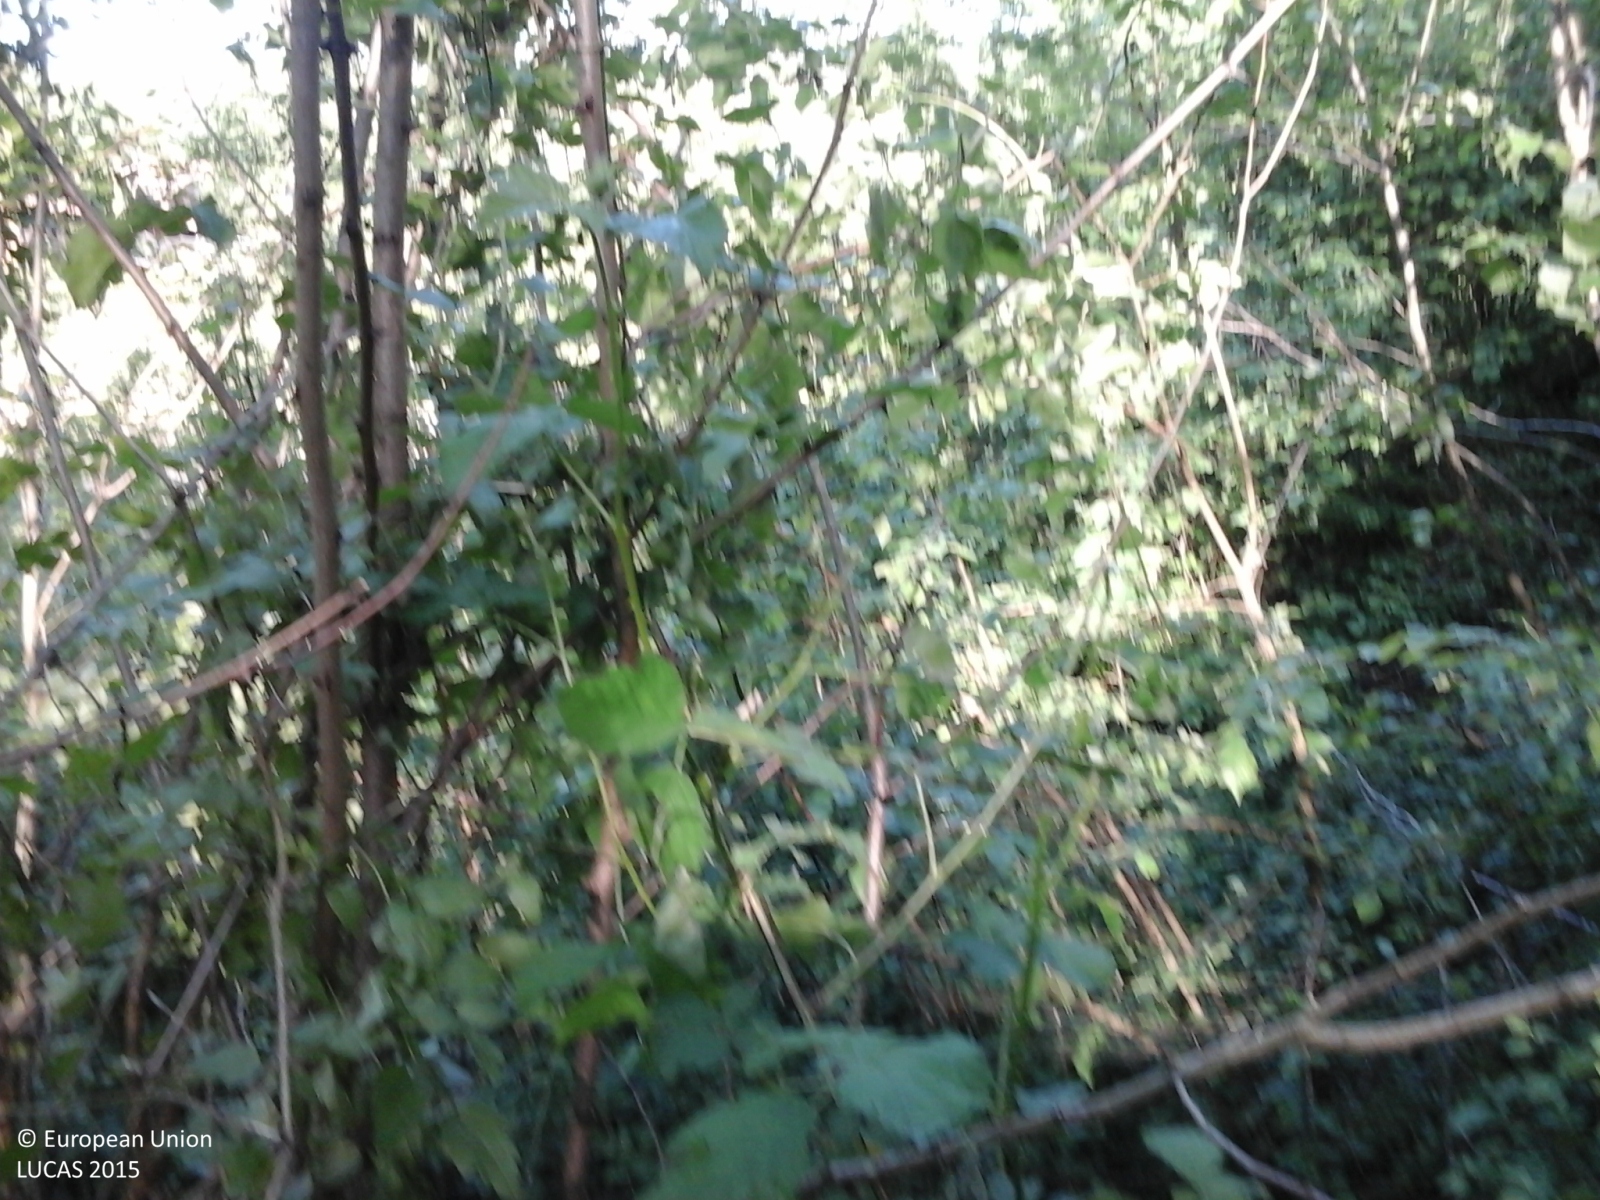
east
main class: Woodland
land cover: Broadleaved woodland
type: mesophytic deciduous forest
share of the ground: > 75 %
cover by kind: broadleaved forest trees 100 %
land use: Forestry
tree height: > 5 m
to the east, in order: Broadleaved woodland; Rivers and streams; Abandoned hedges; Spontaneously vegetated surfaces; Grassland without tree/shrub cover; Shrubland without tree cover; Broadleaved woodland; Spontaneously vegetated surfaces; Lines of trees; Spontaneously vegetated surfaces; Ditches and canals; Spontaneously vegetated surfaces
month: May
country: IT
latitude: 45.1255
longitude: 8.0329
